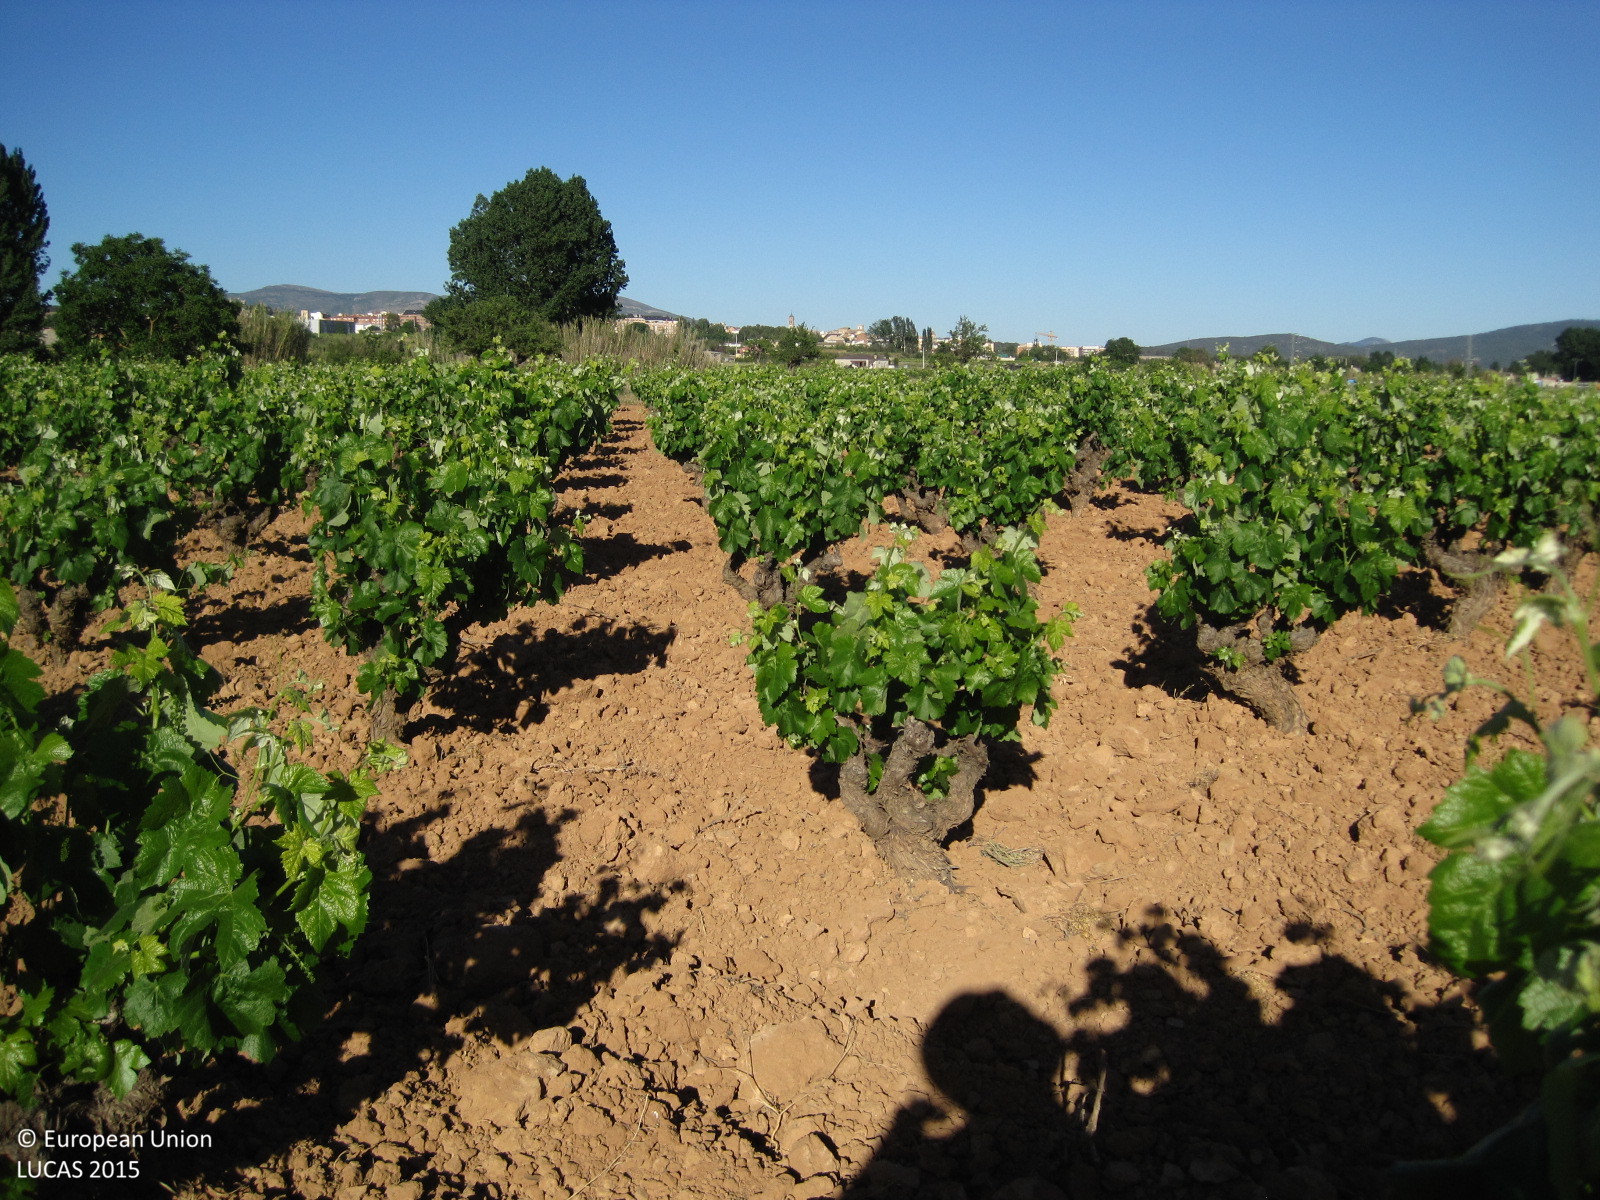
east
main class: Cropland
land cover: Vineyards
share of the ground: 25 - 50 %
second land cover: Other bare soil
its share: > 75 %
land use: Agriculture (excluding fallow land and kitchen gardens)
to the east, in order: Vineyards; Other bare soil; Spontaneously vegetated surfaces; Grassland with sparse tree/shrub cover; Ditches and canals; Vineyards; Spontaneously vegetated surfaces; Rivers and streams; Grassland with sparse tree/shrub cover; Vineyards
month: May
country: ES
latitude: 39.4862
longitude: -1.1281
